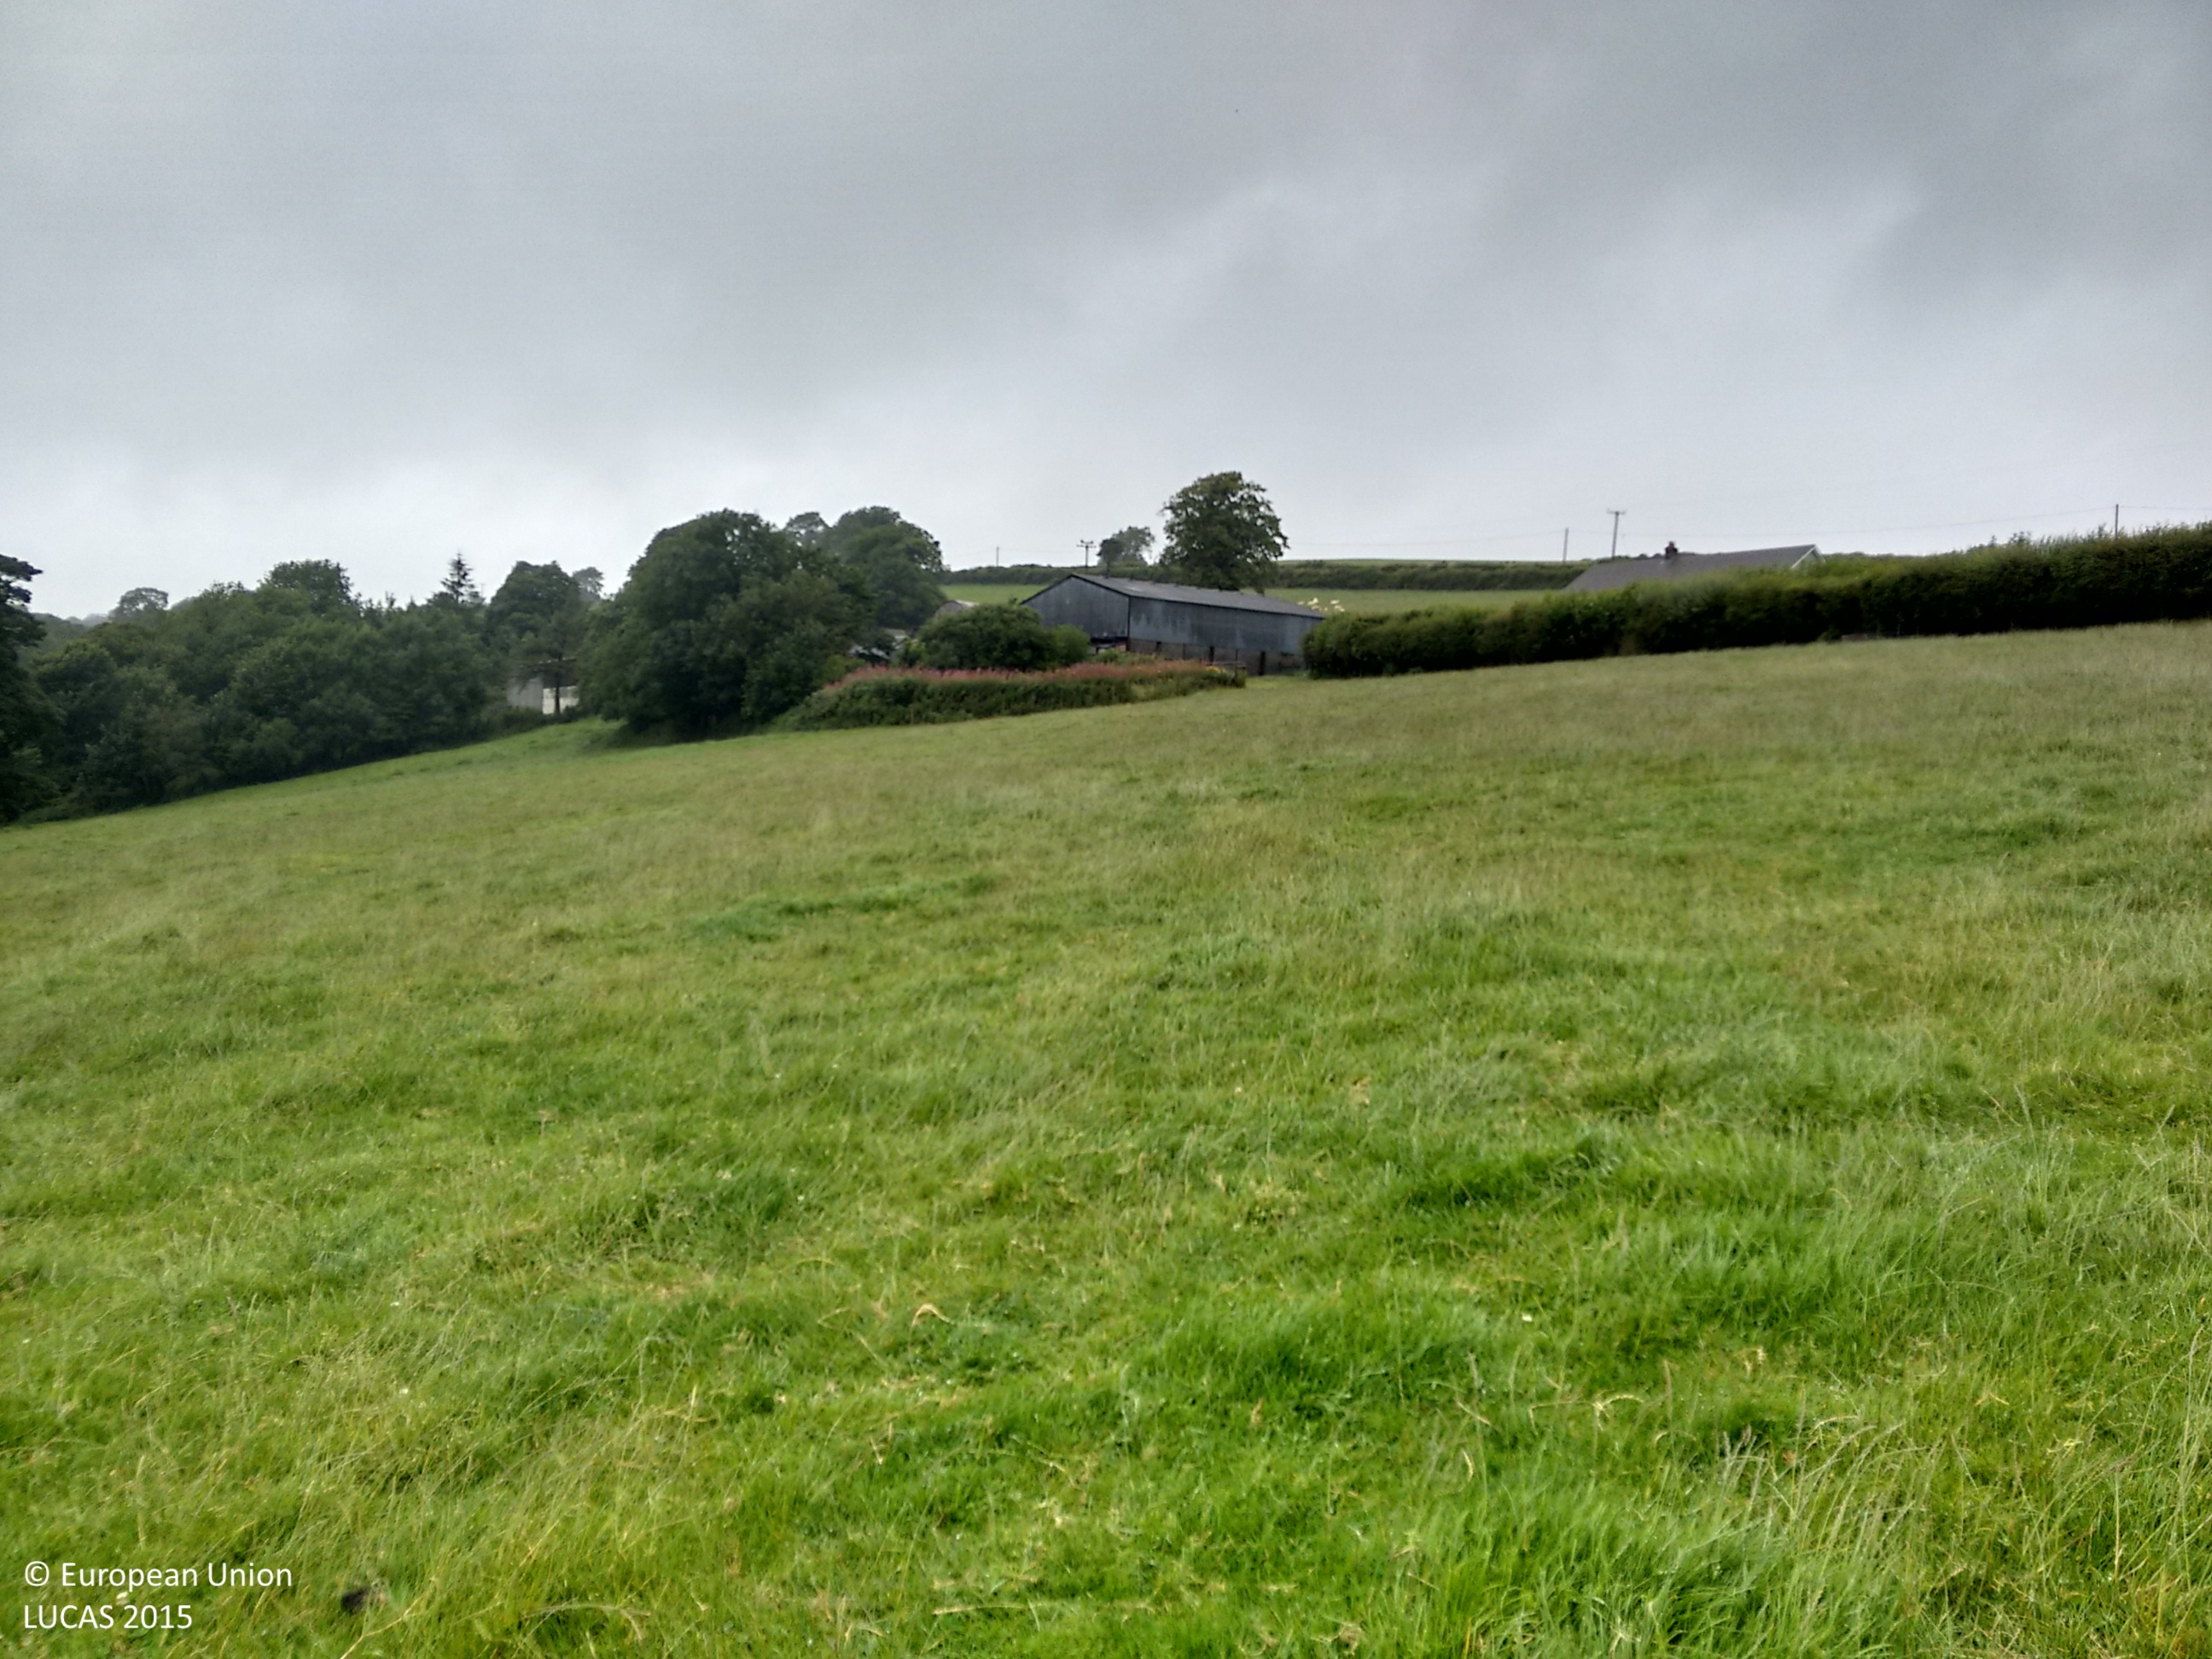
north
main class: Grassland
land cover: Grassland without tree/shrub cover
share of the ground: > 75 %
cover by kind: herbaceous plants 100 %
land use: Agriculture (excluding fallow land and kitchen gardens)
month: August
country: GB
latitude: 51.9072
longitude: -4.4511
